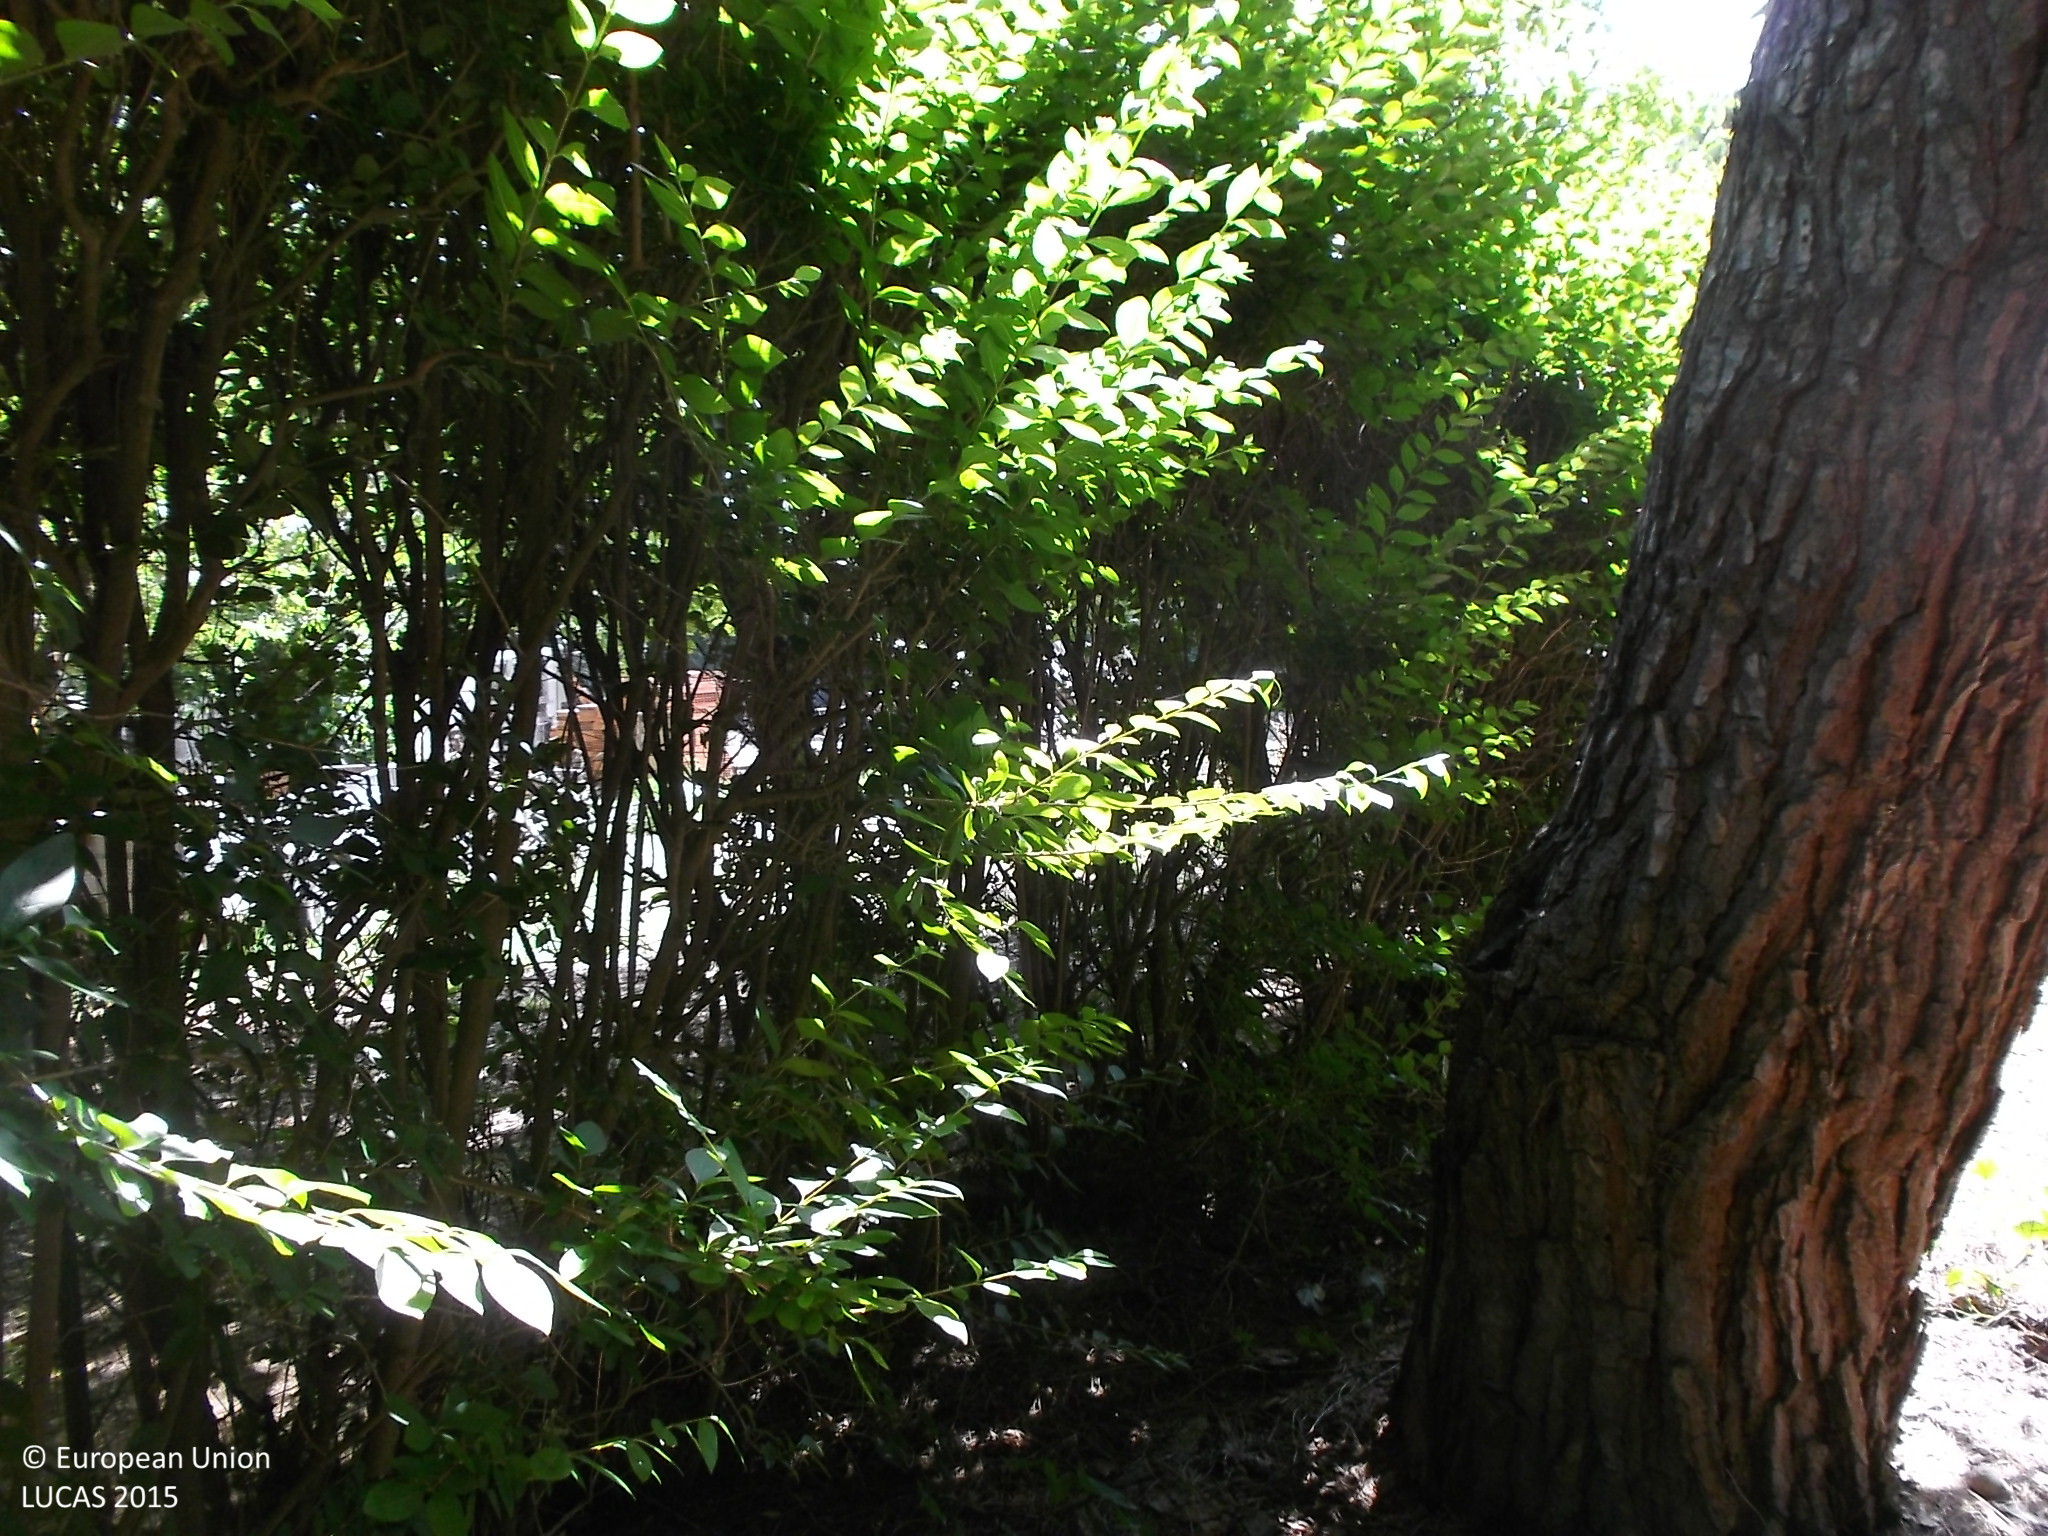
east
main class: Woodland
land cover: Broadleaved woodland
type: broadleaved evergreen forest
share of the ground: > 75 %
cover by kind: broadleaved forest trees 80 %, herbaceous plants 20 %
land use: Residential
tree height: < 5 m
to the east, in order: Broadleaved woodland; Fences; Pine dominated coniferous woodland; Fences; Pine dominated coniferous woodland; Fences; Pine dominated coniferous woodland; Fences; Grassland with sparse tree/shrub cover; Fences; Broadleaved woodland; Inland fresh running water
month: July
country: ES
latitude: 41.4904
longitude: -5.3745
